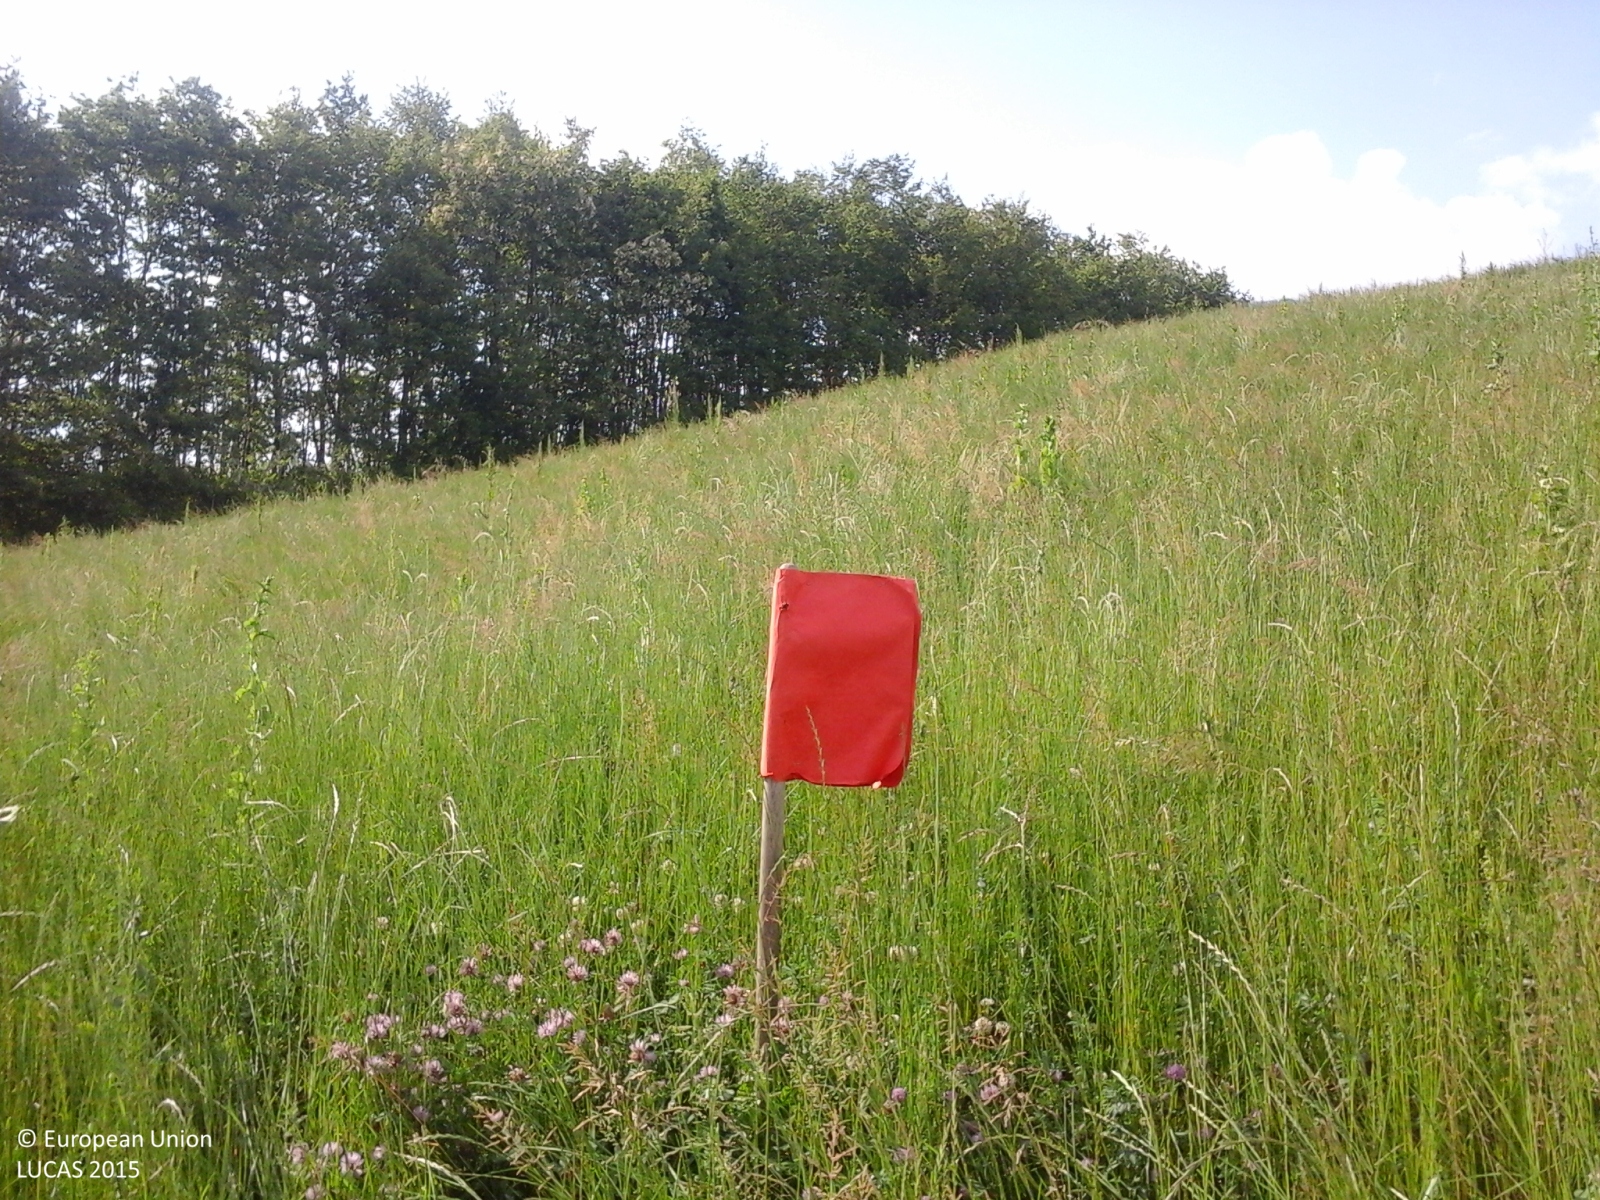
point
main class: Grassland
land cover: Spontaneously vegetated surfaces
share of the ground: > 75 %
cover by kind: herbaceous plants 100 %
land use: Agriculture (excluding fallow land and kitchen gardens)
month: May
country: IT
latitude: 44.5123
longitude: 9.6611
